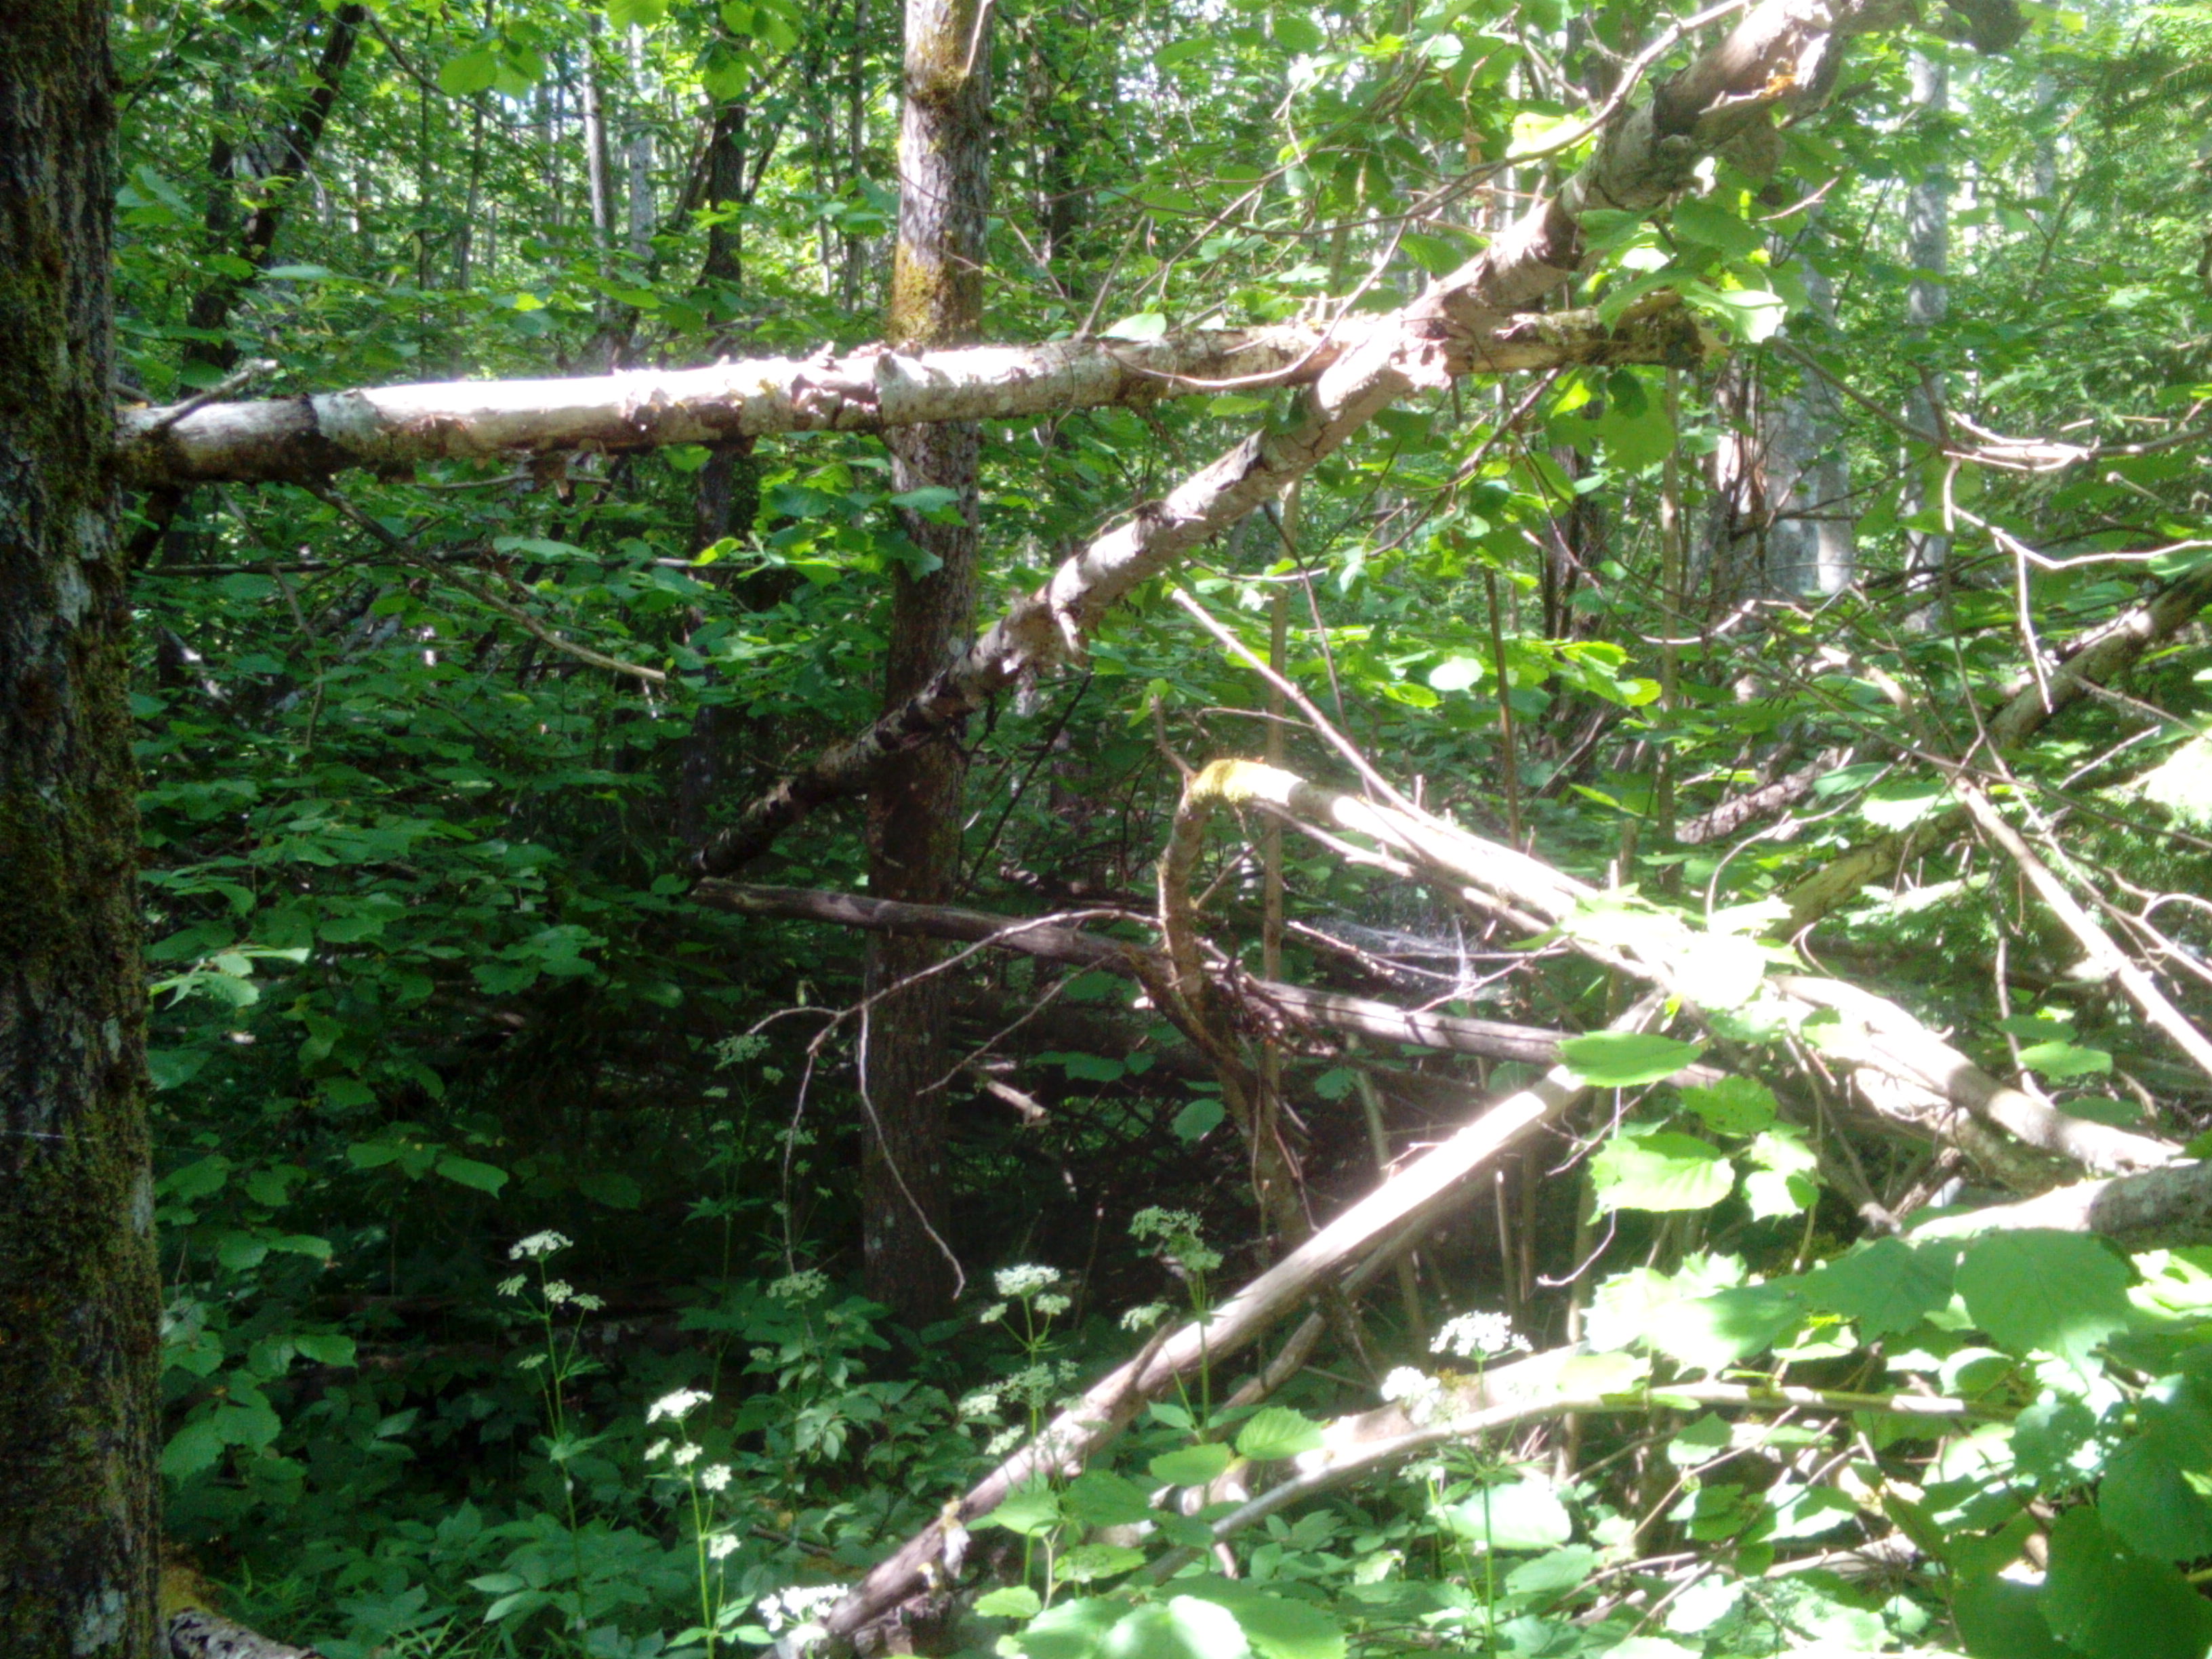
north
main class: Woodland
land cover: Broadleaved woodland
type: non-riverine alder, birch or aspen forest
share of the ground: > 75 %
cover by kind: broadleaved forest trees 90 %, shrubs 5 %, herbaceous plants 5 %
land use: Forestry
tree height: > 5 m
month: June
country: LV
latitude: 56.8126
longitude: 21.7233
